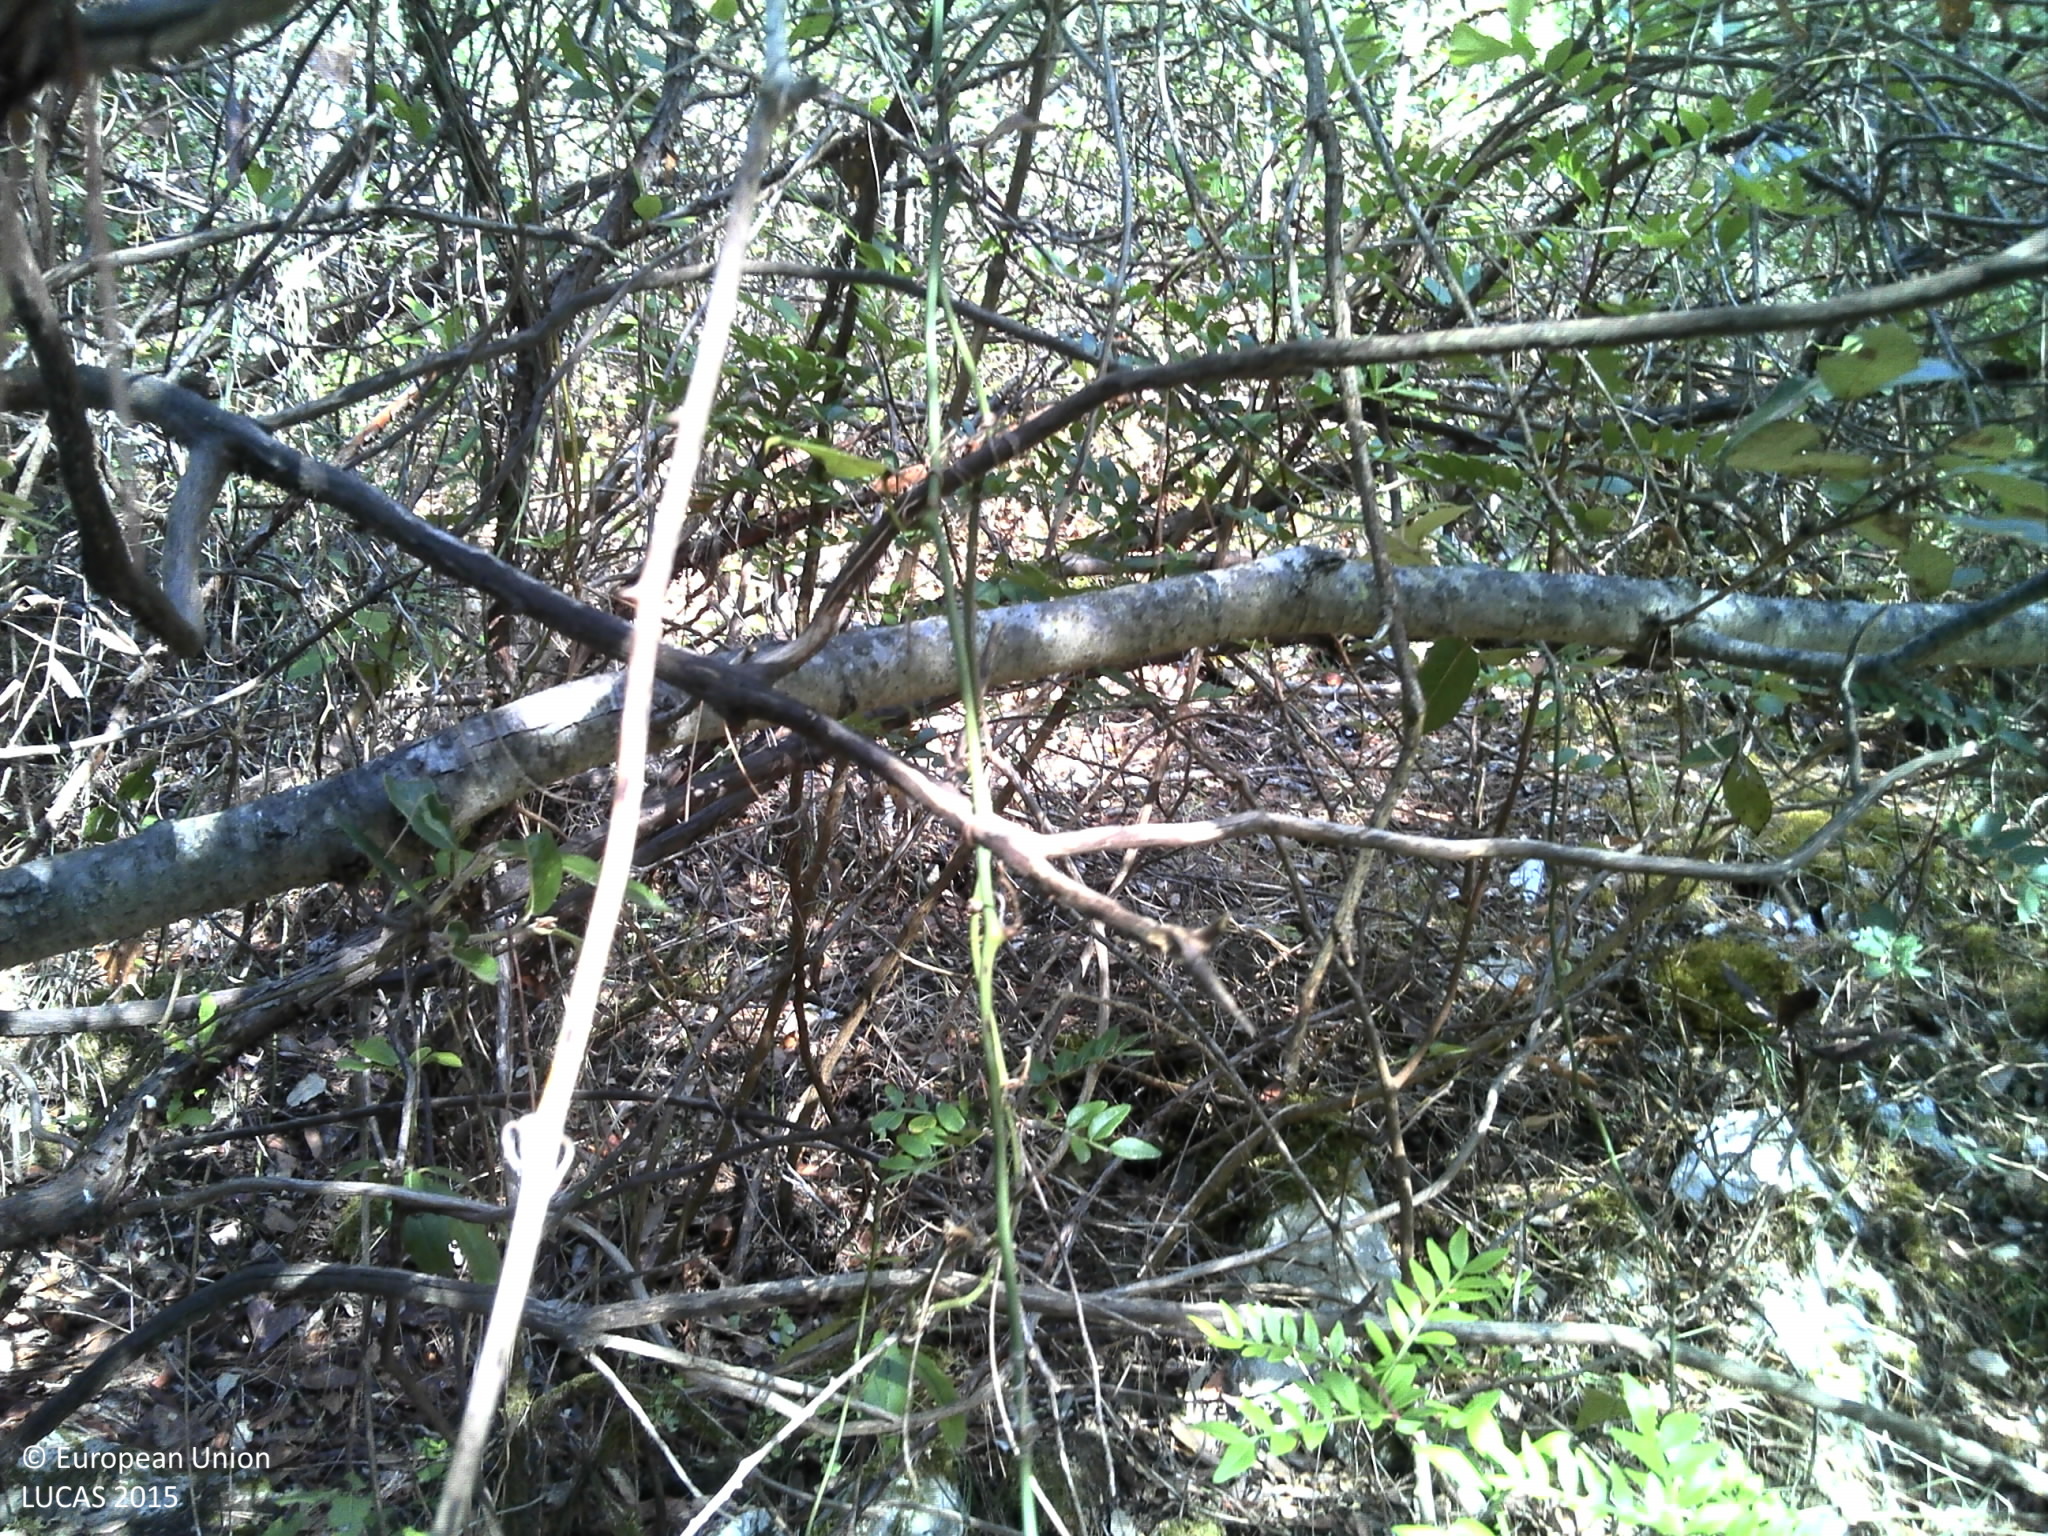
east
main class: Woodland
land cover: Pine dominated mixed woodland
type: coniferous forest of the mediterranean region
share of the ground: > 75 %
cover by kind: shrubs 50 %, coniferous forest trees 25 %, broadleaved forest trees 10 %, consolidated bare surface 10 %, lichens and mosses 5 %
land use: Semi-natural and natural areas not in use
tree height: > 5 m
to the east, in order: Pine dominated mixed woodland; Shrubland with sparse tree cover; Pine dominated mixed woodland
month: August
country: HR
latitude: 43.1440
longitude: 16.8876
